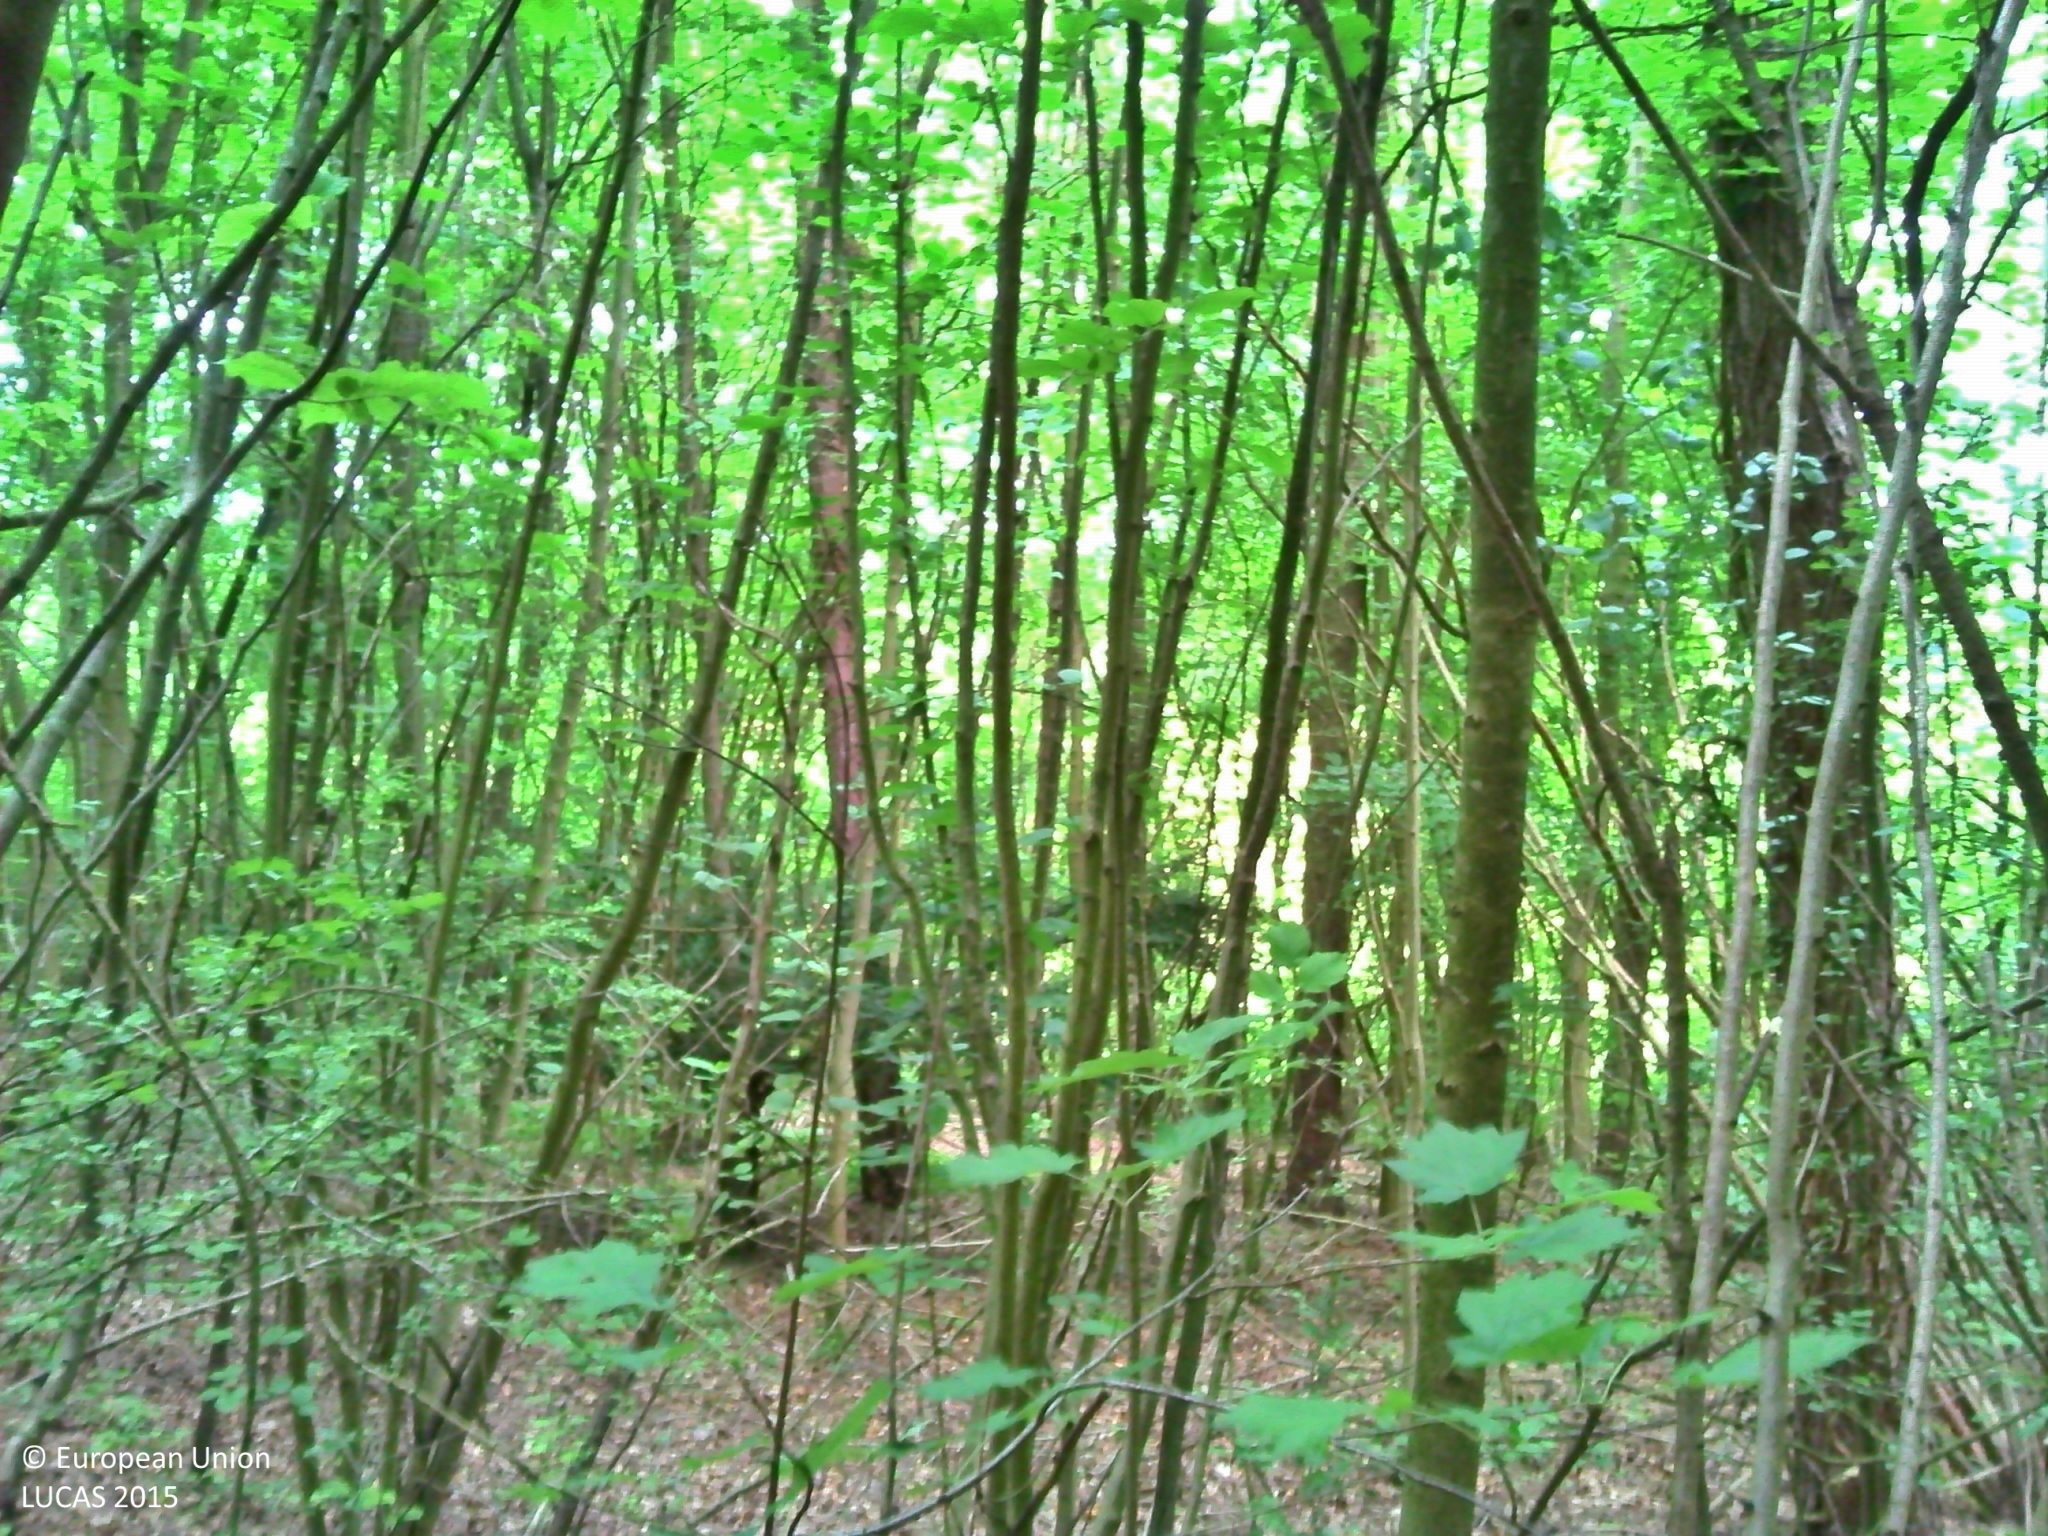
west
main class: Woodland
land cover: Broadleaved woodland
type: beech forest
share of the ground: > 75 %
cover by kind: broadleaved forest trees 85 %, herbaceous plants 10 %, shrubs 5 %
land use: Forestry
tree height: > 5 m
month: June
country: FR
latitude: 49.5754
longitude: 2.2281
